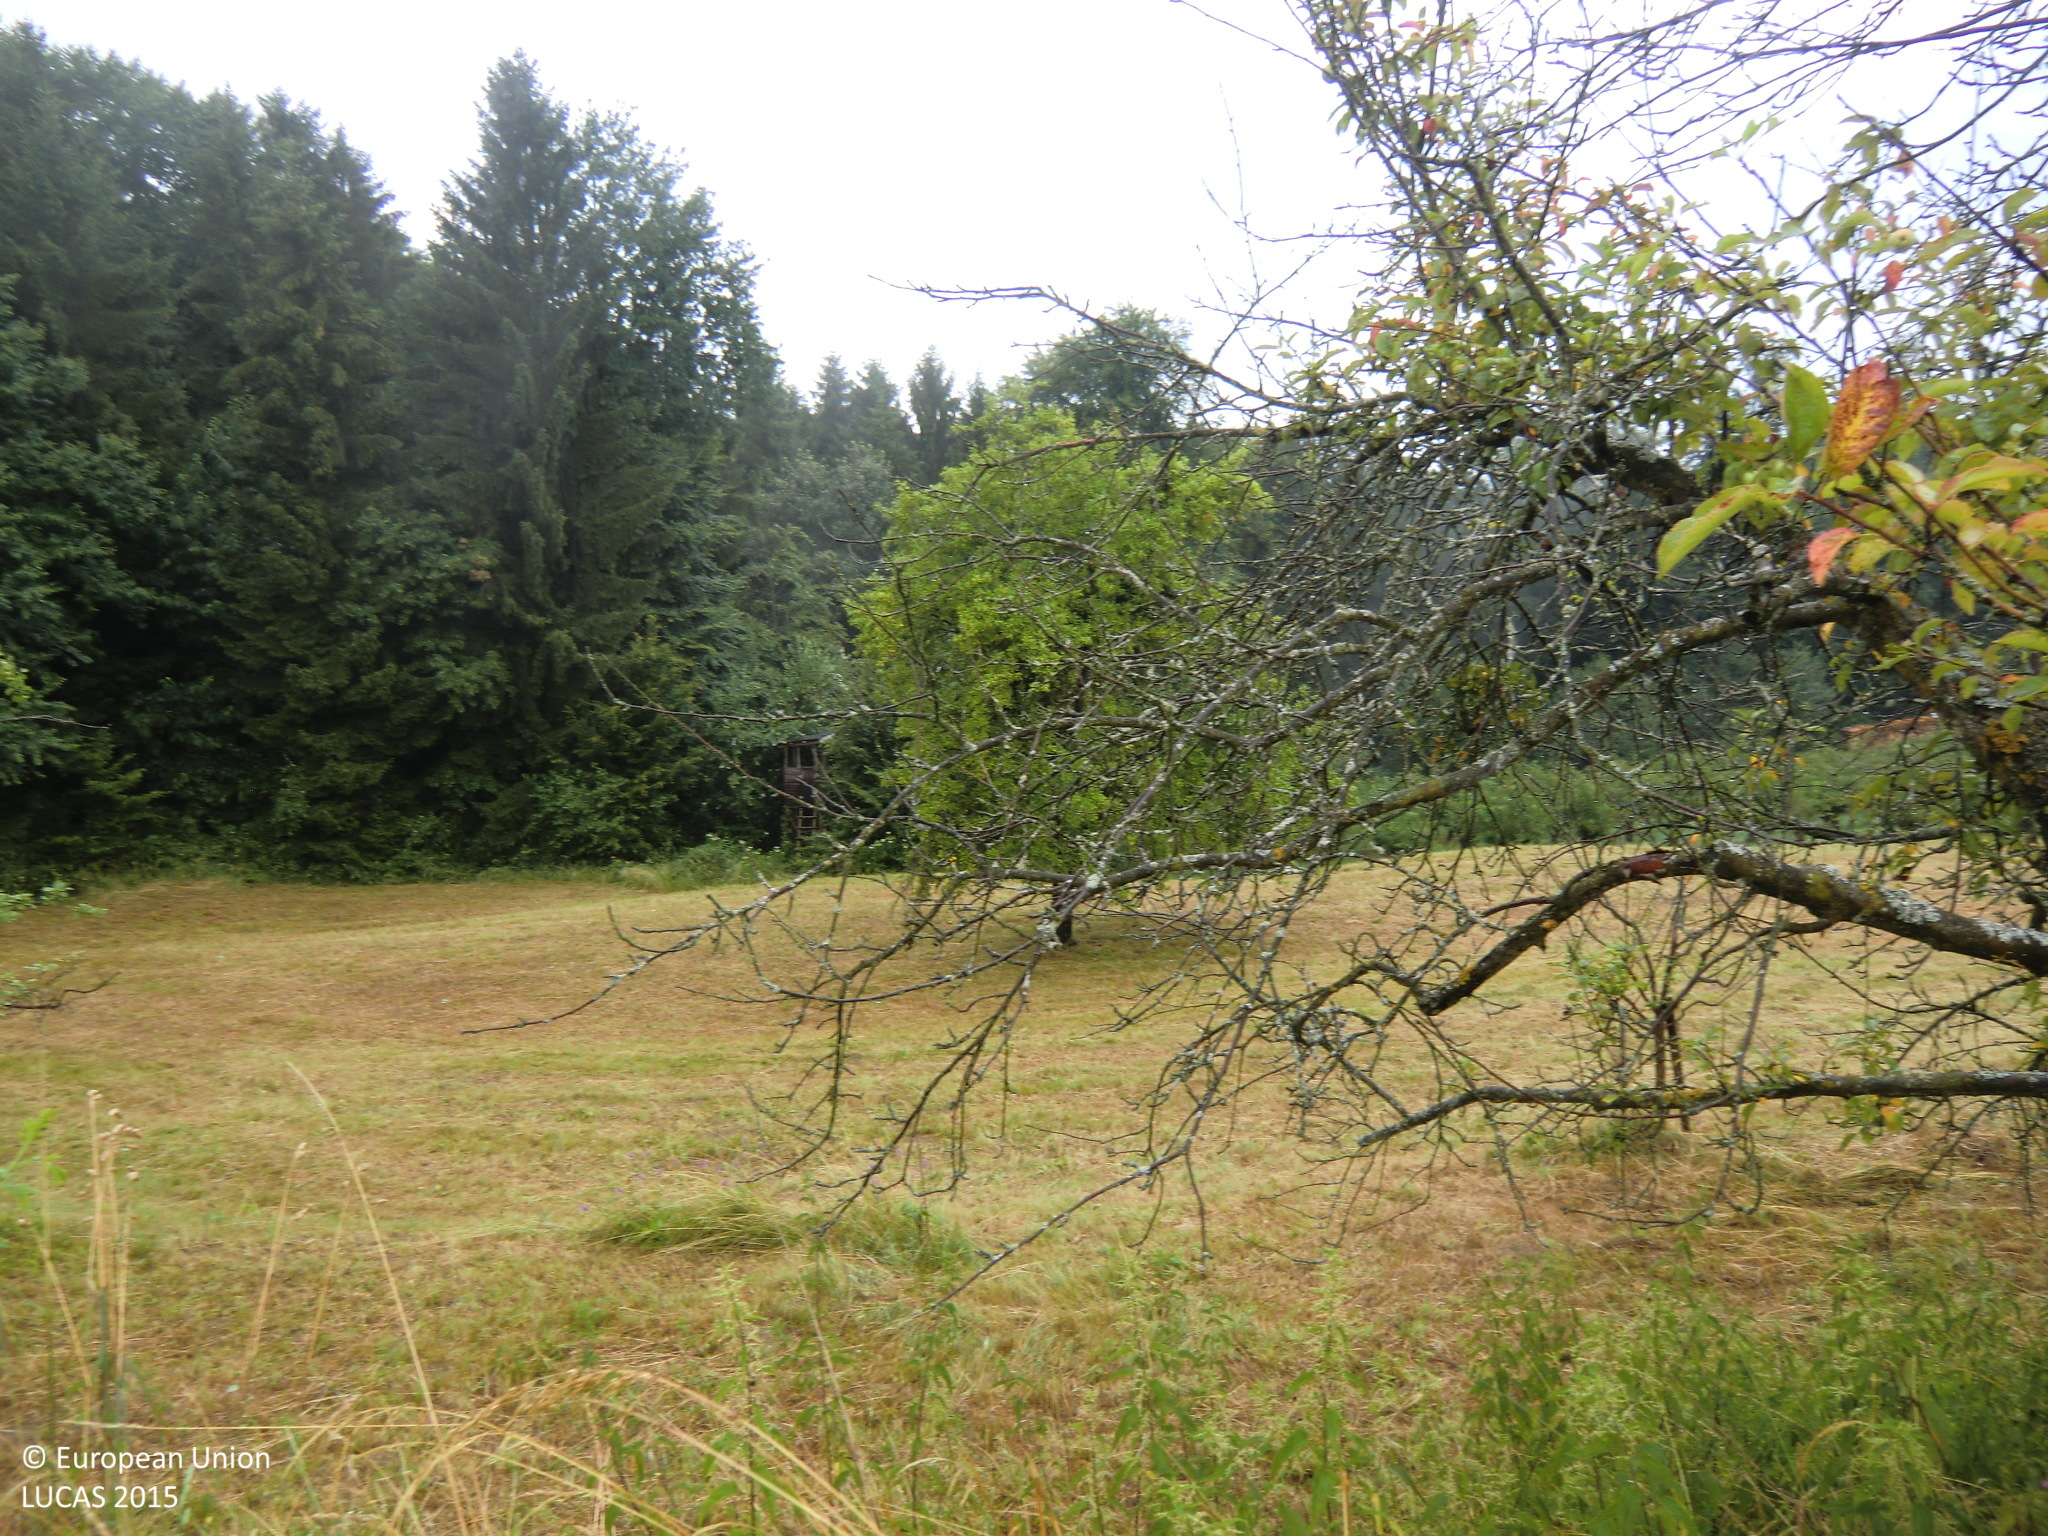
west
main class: Cropland
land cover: Apple fruit
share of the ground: 50 - 75 %
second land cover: Grassland without tree/shrub cover
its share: > 75 %
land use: Agriculture (excluding fallow land and kitchen gardens)
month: July
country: AT
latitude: 47.0184
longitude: 15.9077
